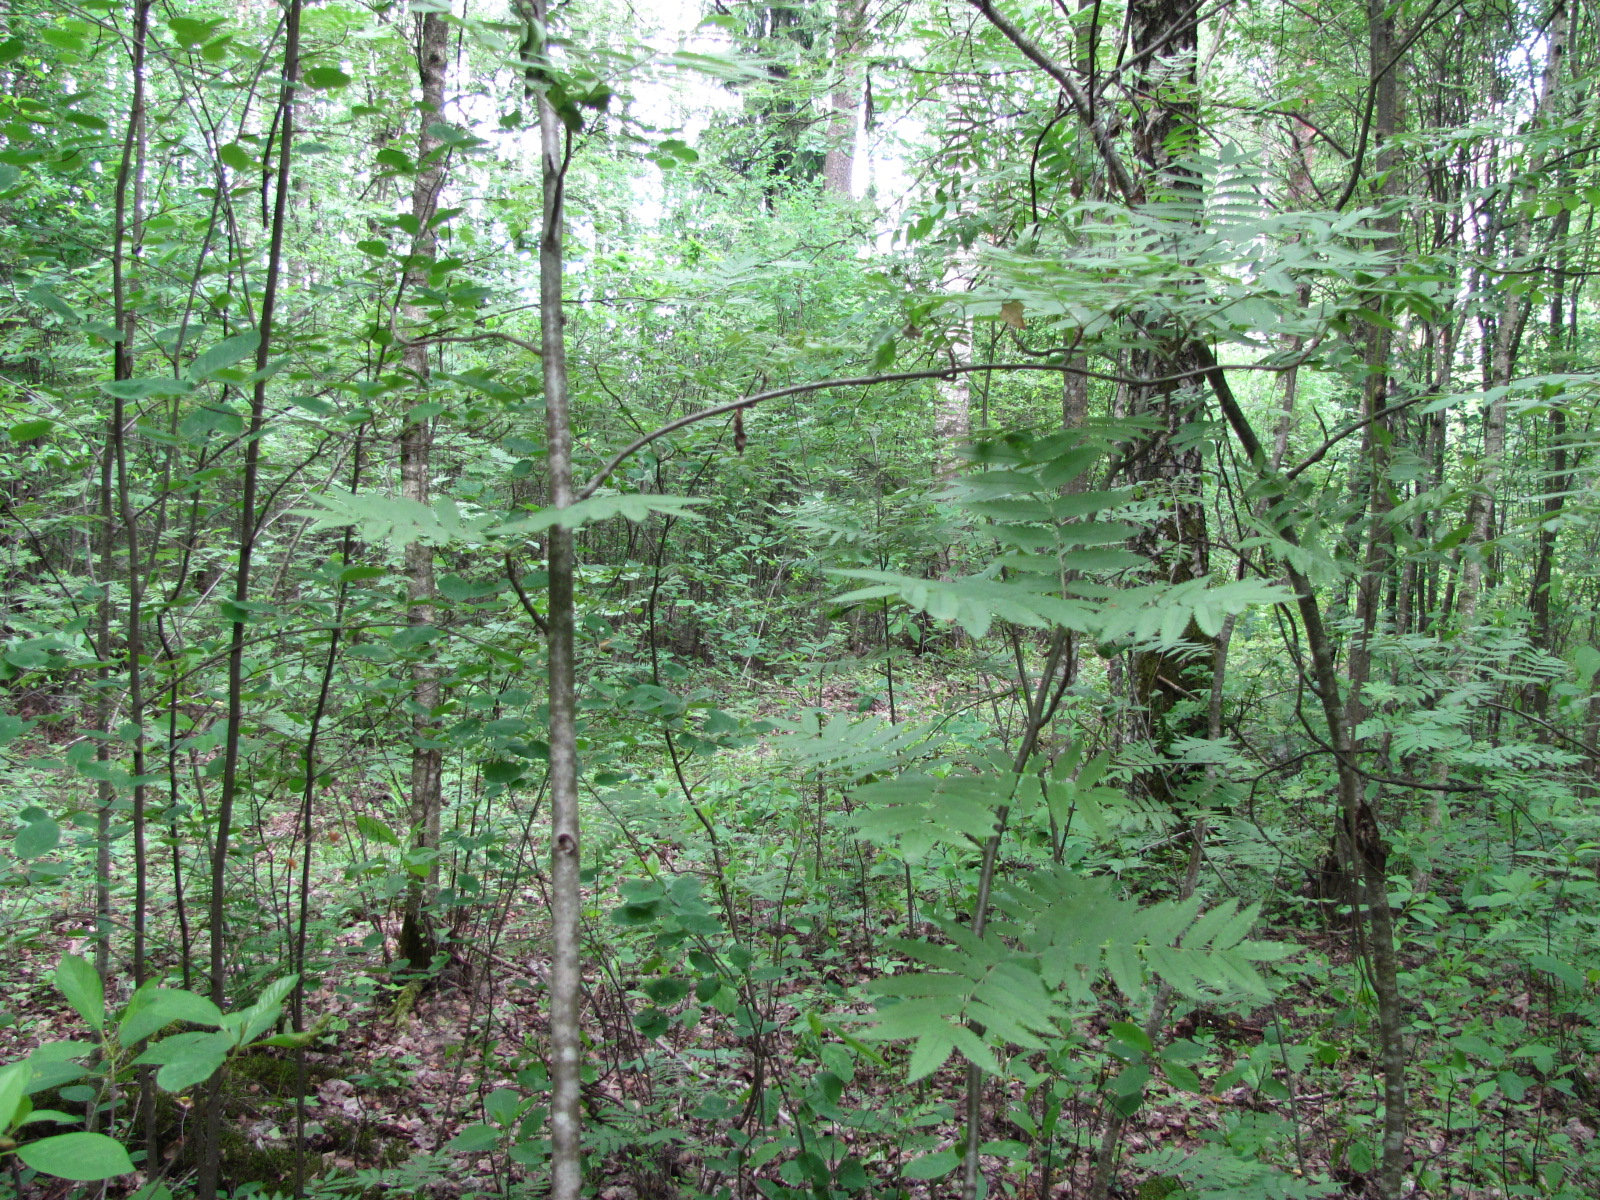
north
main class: Woodland
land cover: Broadleaved woodland
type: non-riverine alder, birch or aspen forest
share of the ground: > 75 %
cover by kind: broadleaved forest trees 100 %
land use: Forestry
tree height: > 5 m
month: June
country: LV
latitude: 56.6336
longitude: 23.8907
